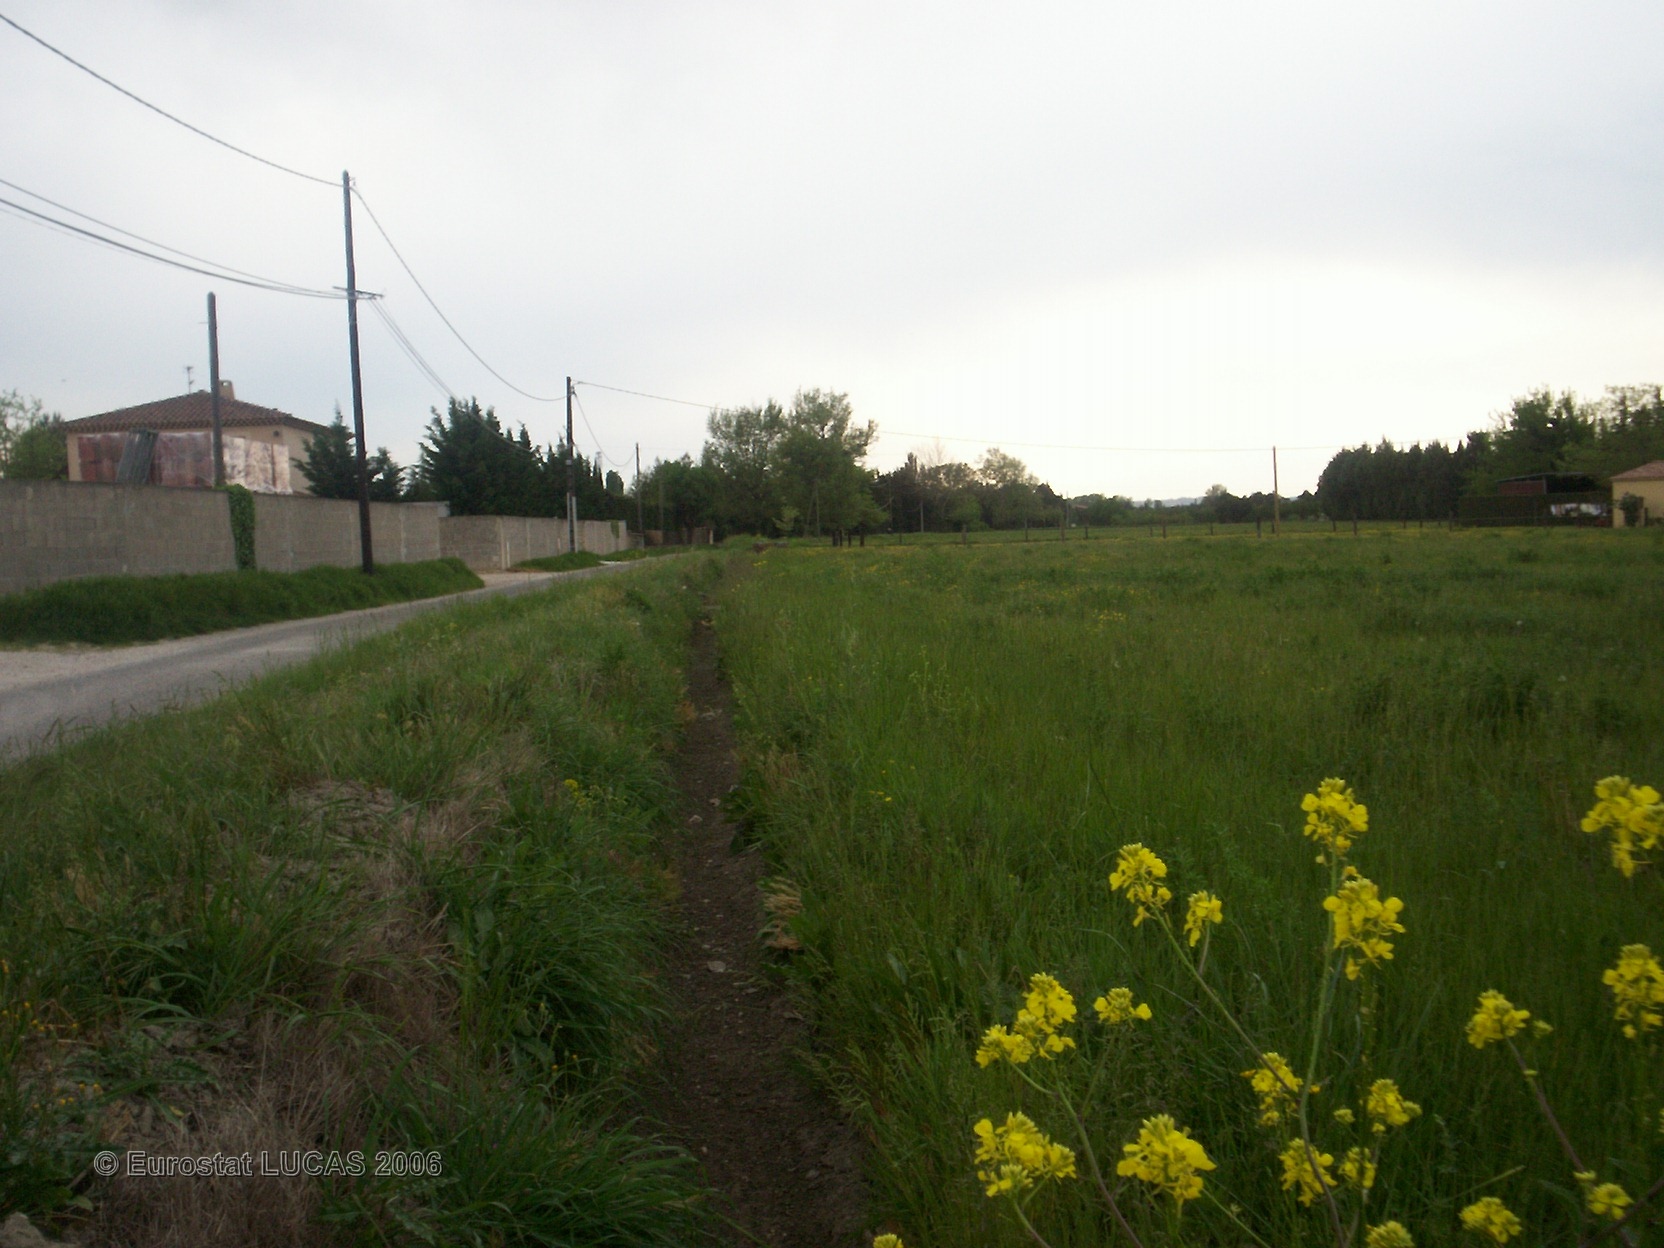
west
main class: Grassland
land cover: Grassland without tree/shrub cover
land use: Agriculture (excluding fallow land and kitchen gardens)
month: April
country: FR
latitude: 44.0483
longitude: 4.9784
